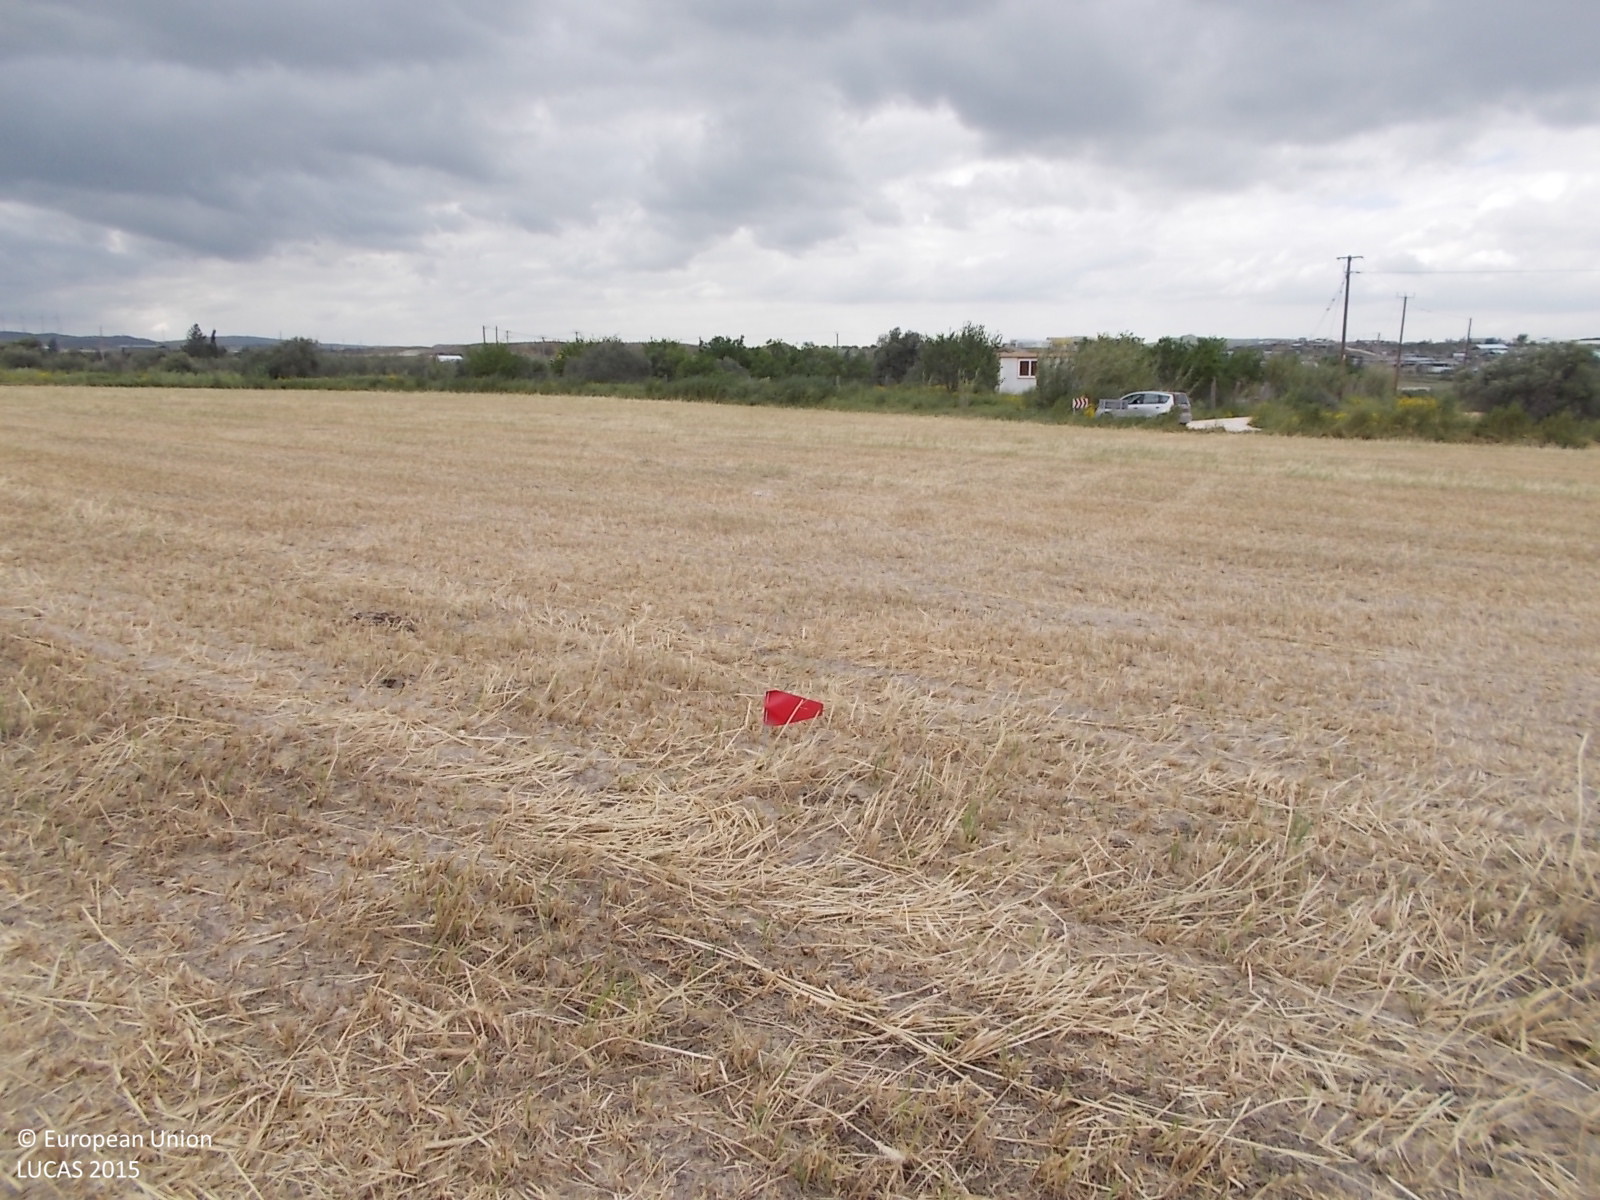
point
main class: Cropland
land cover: Common wheat
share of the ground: < 10 %
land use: Agriculture (excluding fallow land and kitchen gardens)
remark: Harvested field
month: April
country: CY
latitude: 34.9578
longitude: 33.5992
